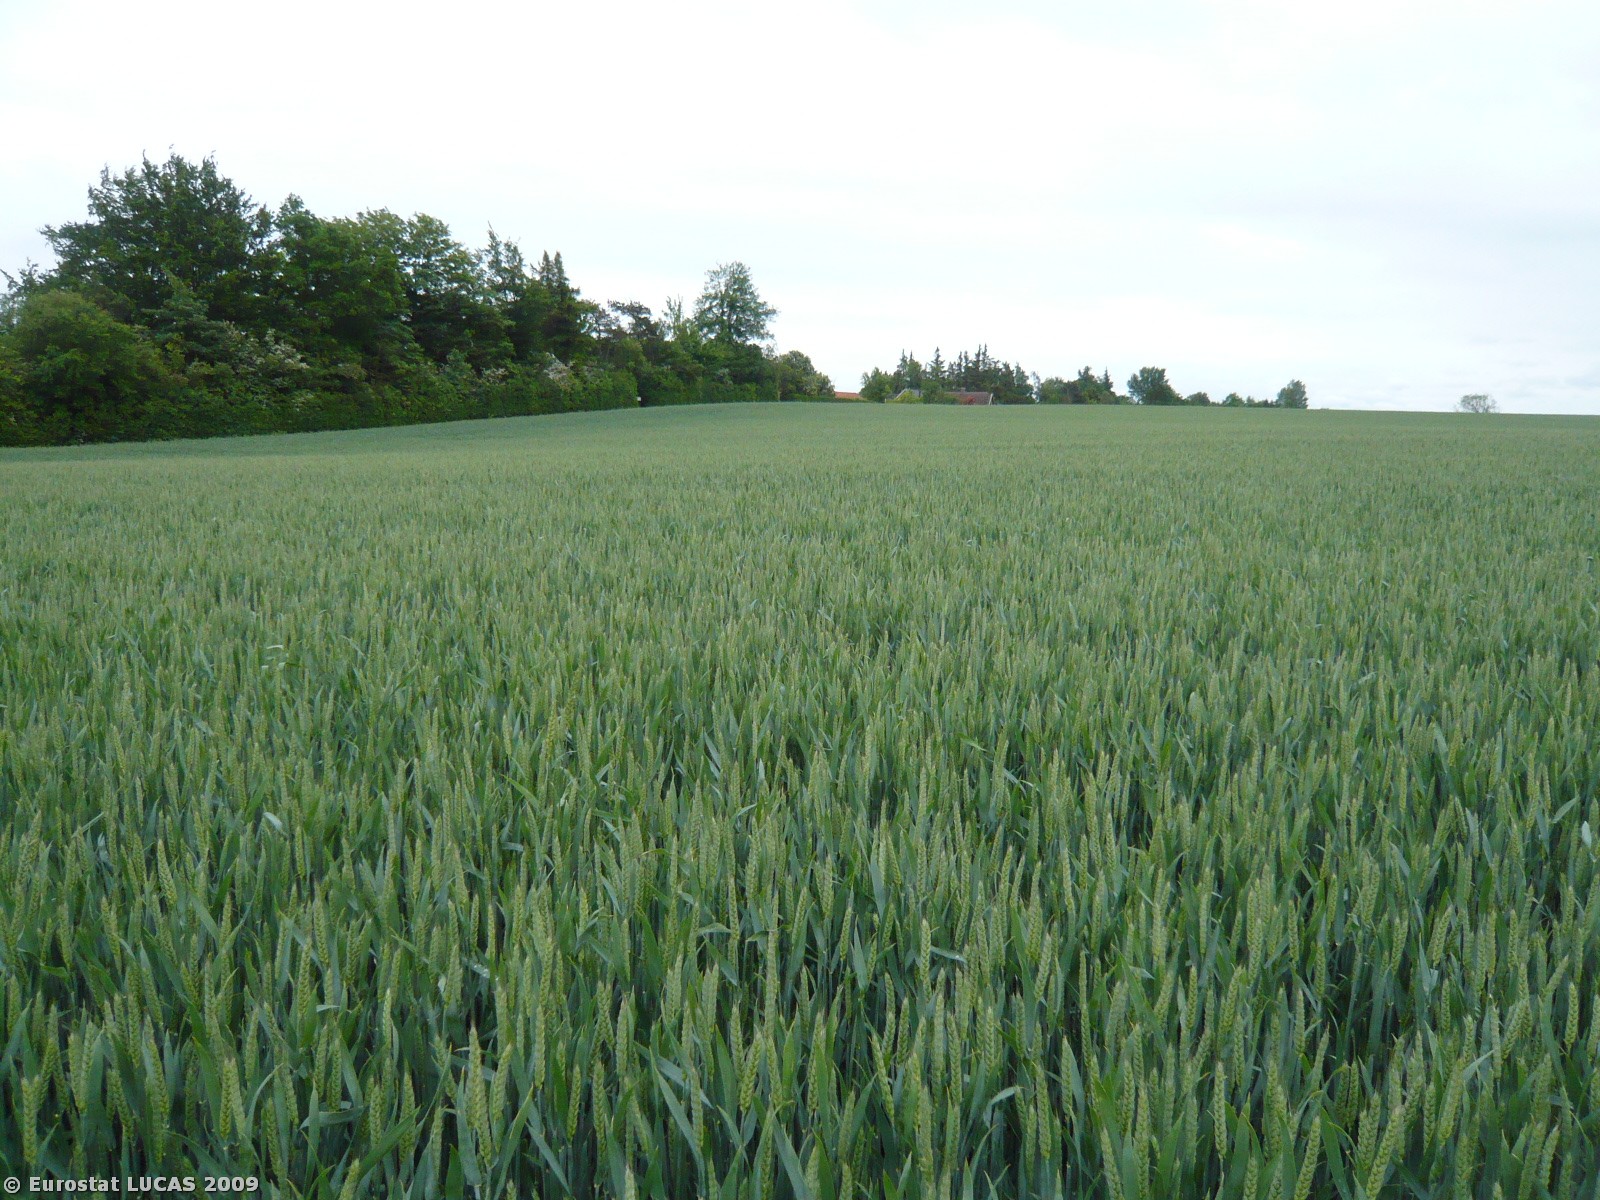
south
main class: Cropland
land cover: Common wheat
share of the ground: > 75 %
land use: Agriculture (excluding fallow land and kitchen gardens)
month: June
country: DK
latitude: 54.7512
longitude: 12.0341
